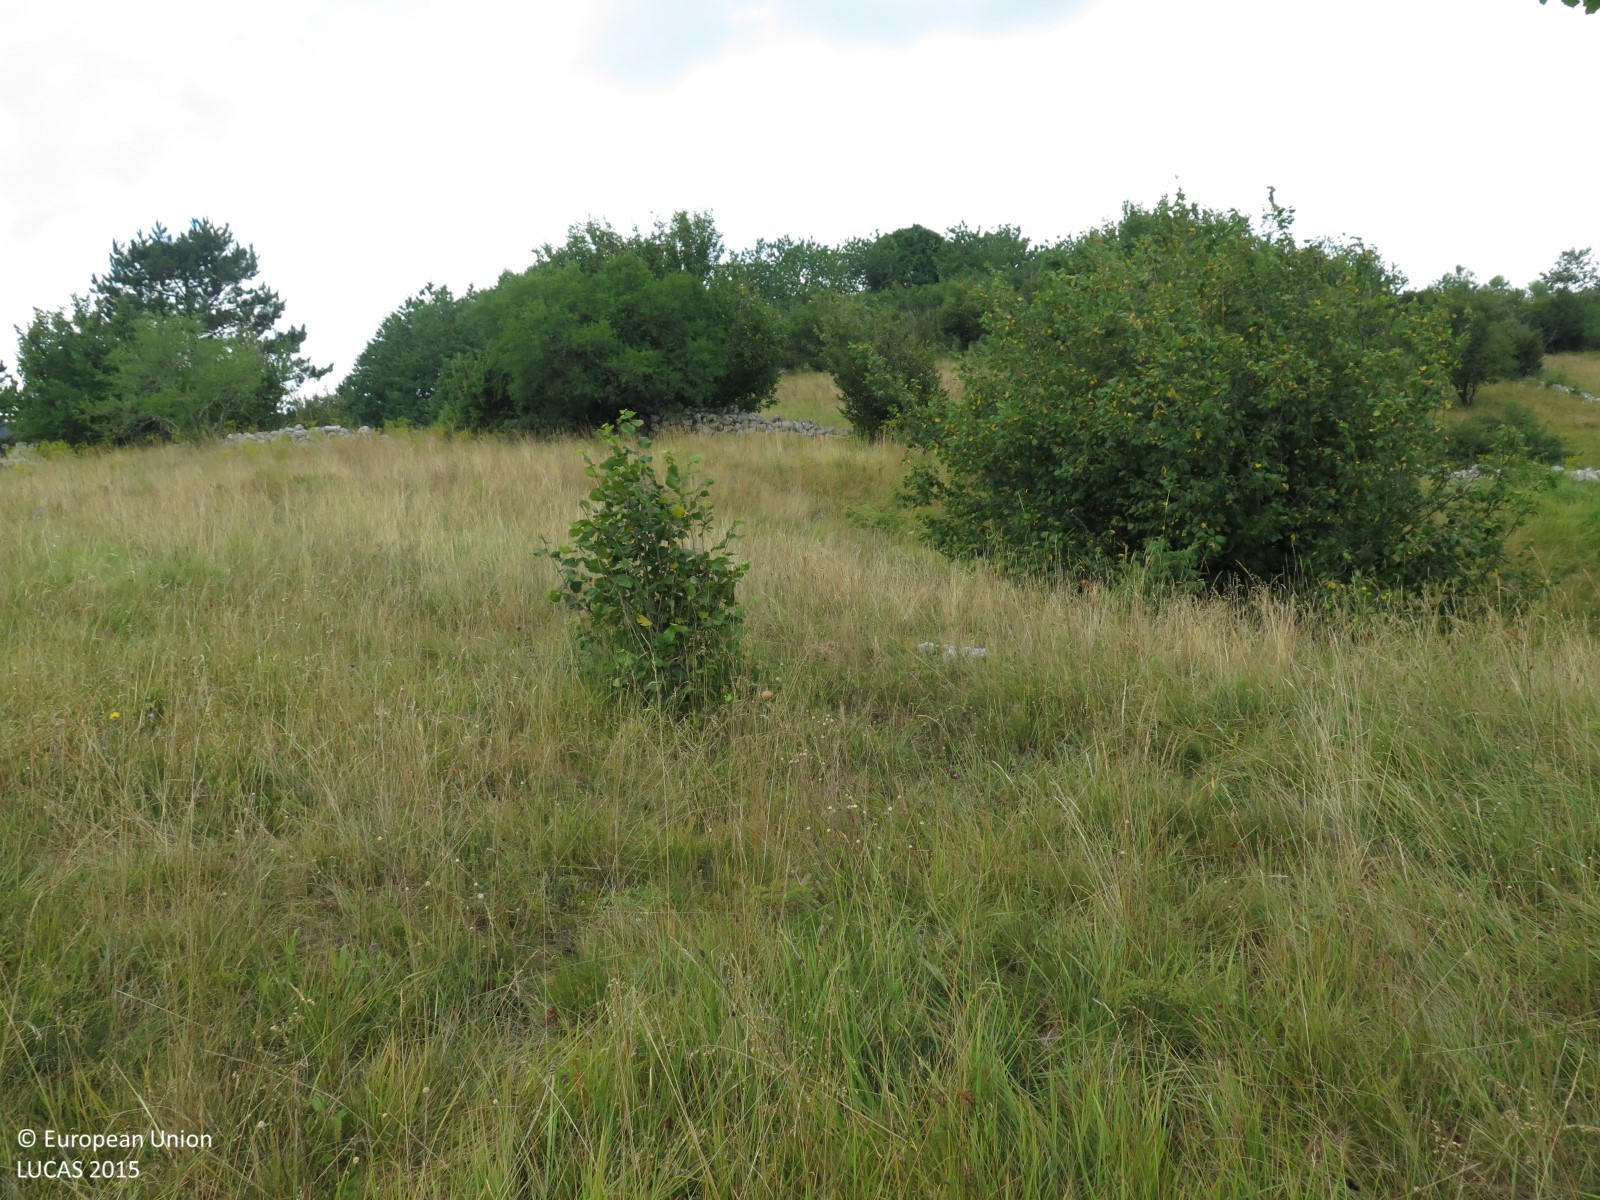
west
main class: Grassland
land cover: Grassland with sparse tree/shrub cover
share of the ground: > 75 %
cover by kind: herbaceous plants 90 %, broadleaved forest trees 5 %, shrubs 5 %
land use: Abandoned areas
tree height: < 5 m
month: July
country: HR
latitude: 45.4439
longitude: 14.0736
